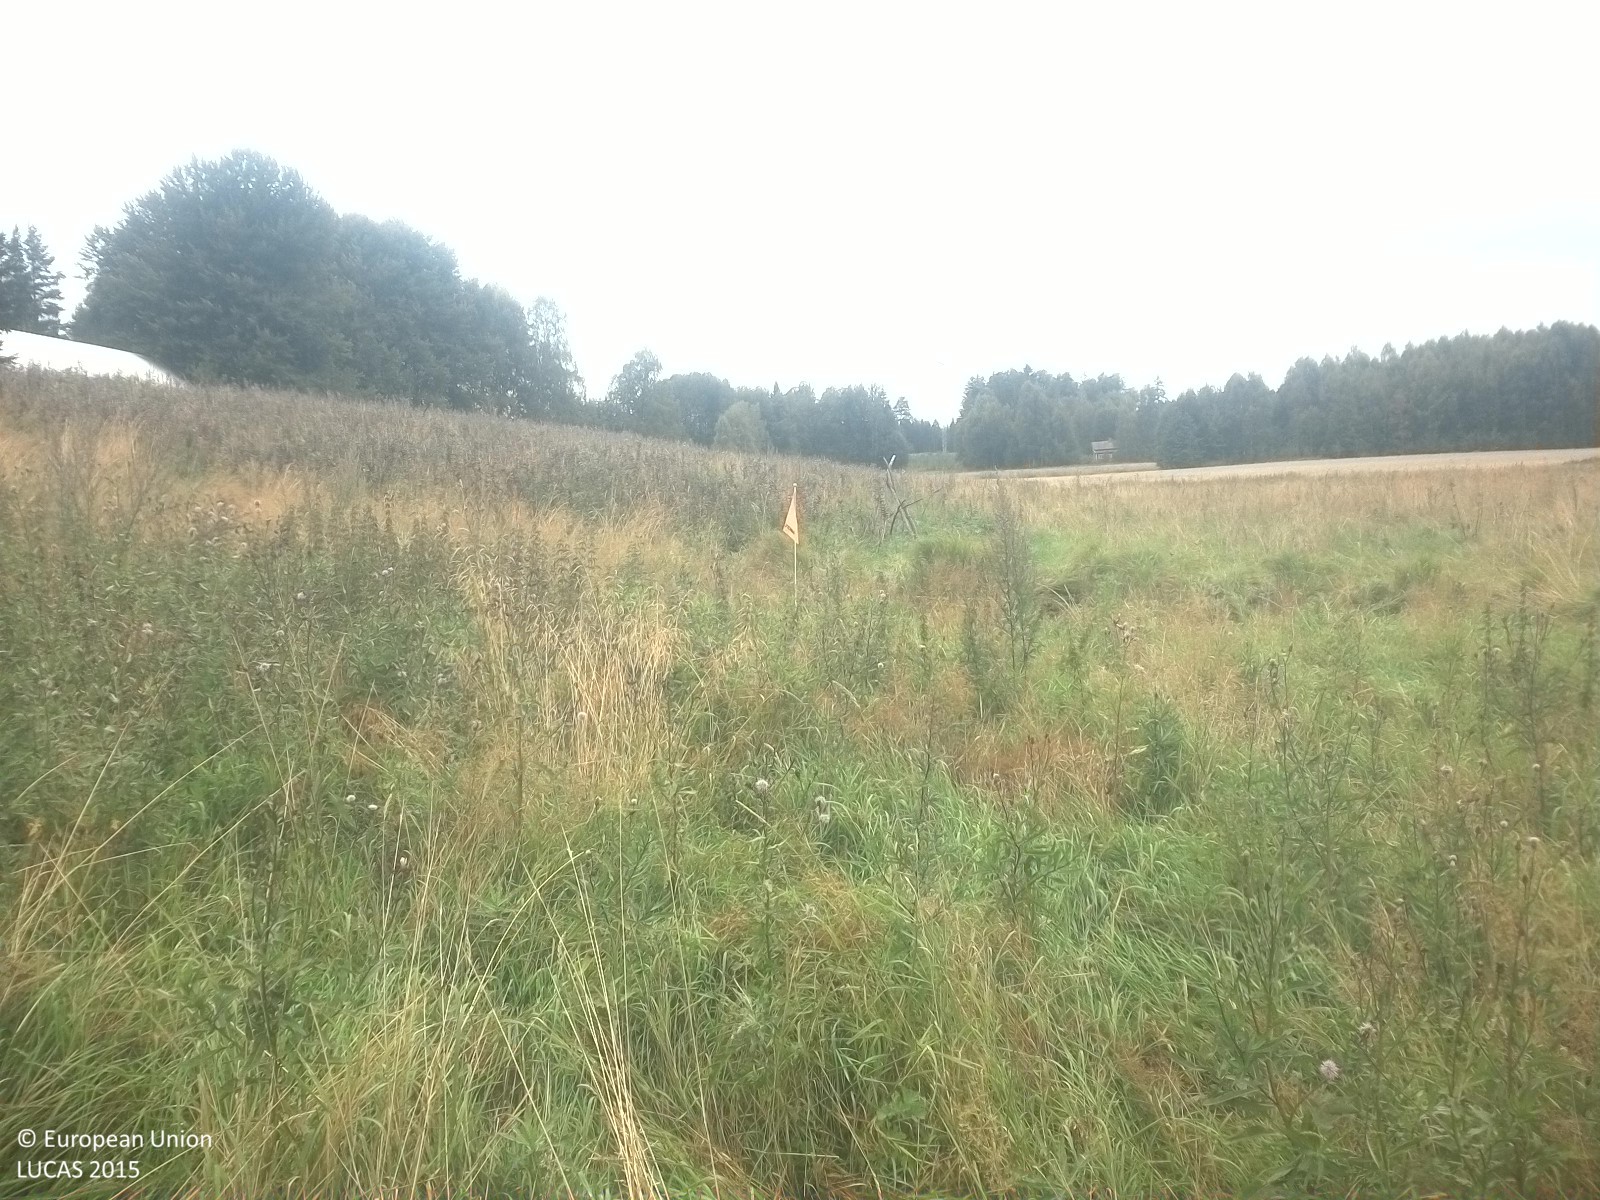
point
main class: Grassland
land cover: Grassland without tree/shrub cover
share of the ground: > 75 %
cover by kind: herbaceous plants 100 %
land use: Agriculture (excluding fallow land and kitchen gardens)
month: September
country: SE
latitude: 59.3725
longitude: 15.4292
